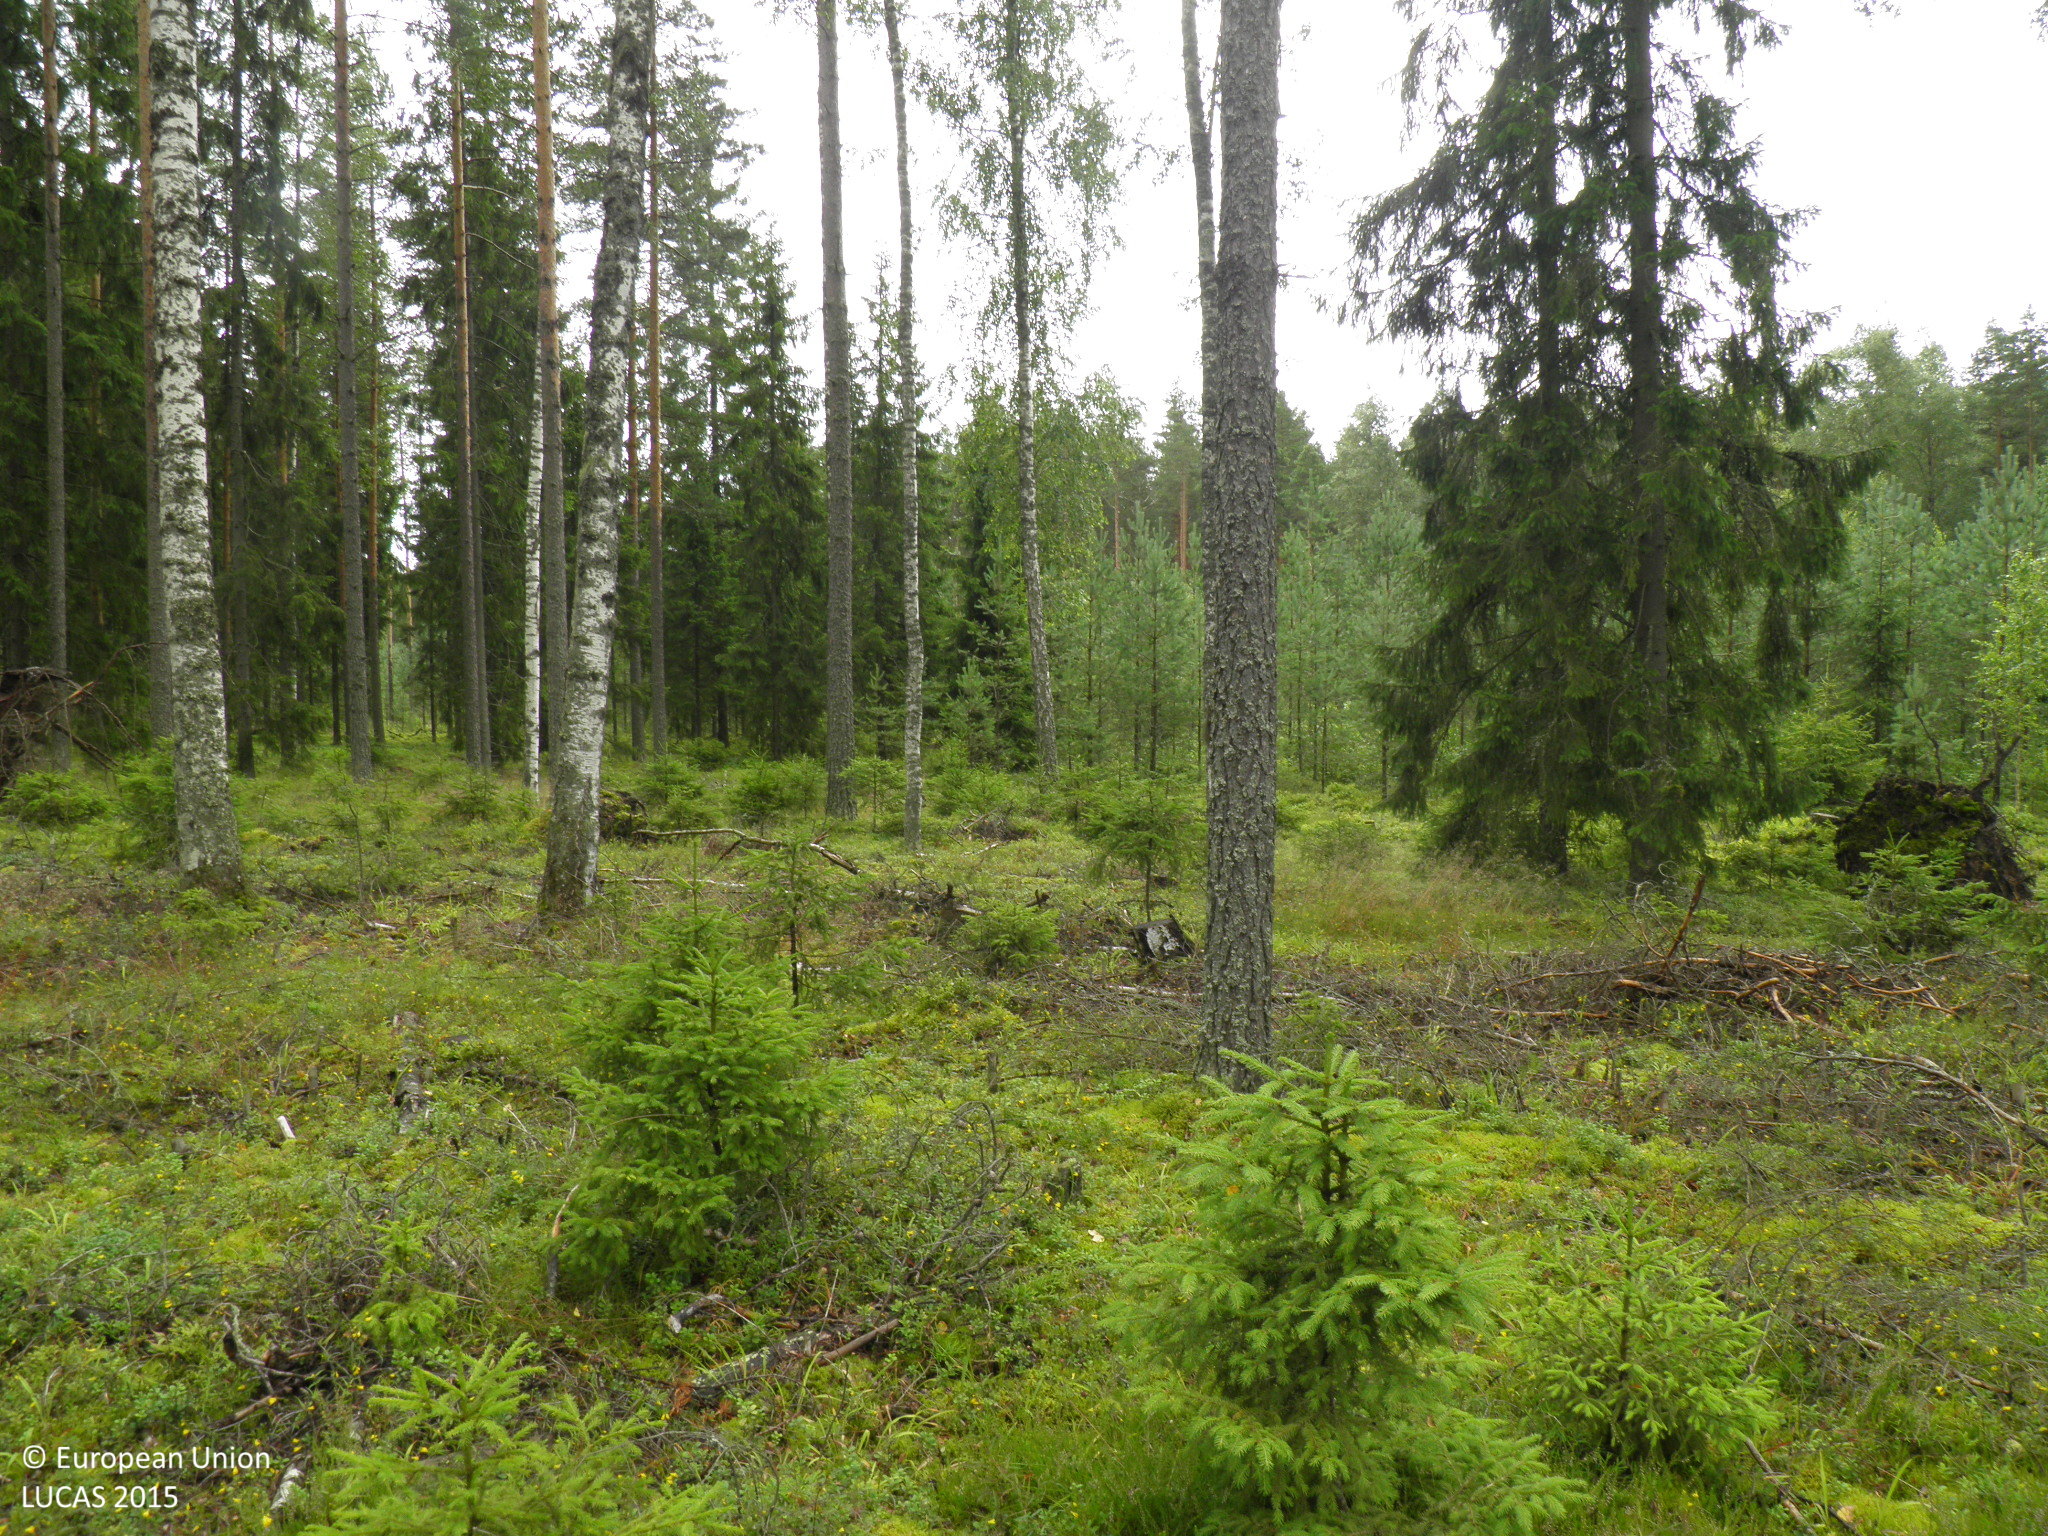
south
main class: Woodland
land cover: Other mixed woodland
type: hemiboreal forest and nemoral coniferous forest and mixed broadleaved-coniferous forest
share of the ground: 25 - 50 %
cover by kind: coniferous forest trees 20 %, broadleaved forest trees 20 %, shrubs 20 %, herbaceous plants 20 %, lichens and mosses 20 %
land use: Forestry
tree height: > 5 m
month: July
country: FI
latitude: 60.8596
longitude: 22.7560
